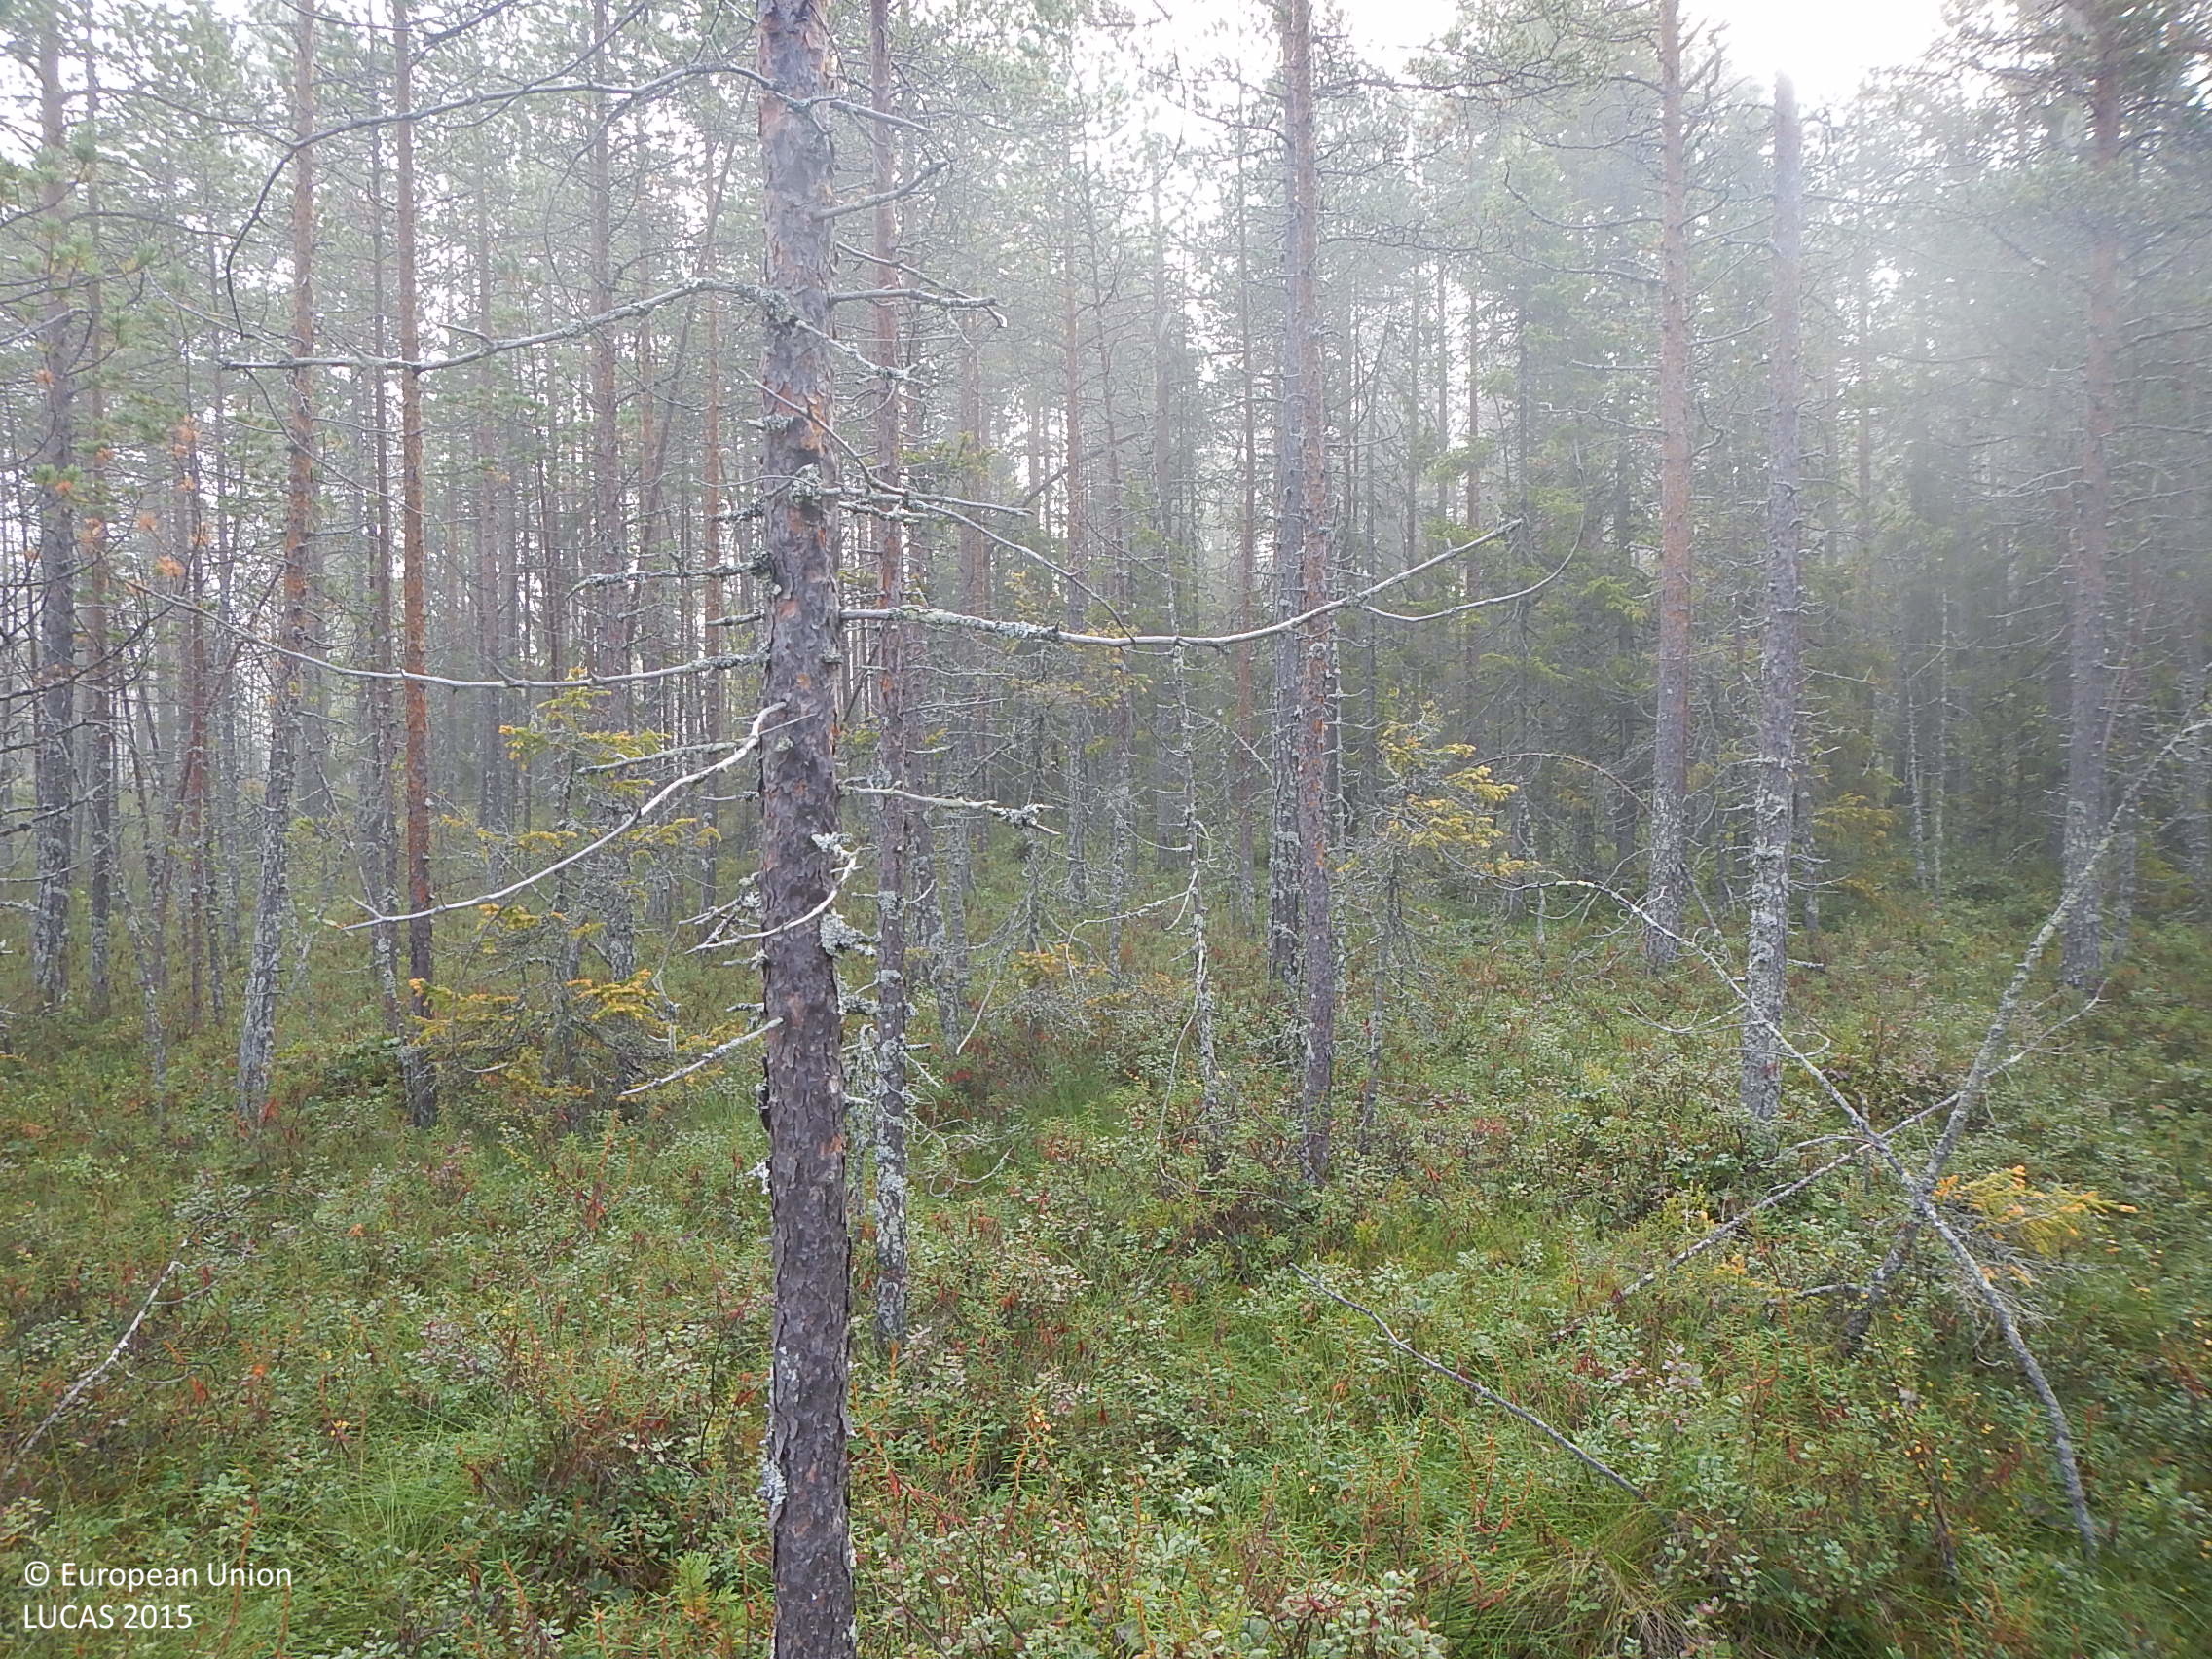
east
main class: Woodland
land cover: Pine dominated coniferous woodland
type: mire and swamp forests
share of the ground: 25 - 50 %
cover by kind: coniferous forest trees 45 %, shrubs 40 %, herbaceous plants 10 %, lichens and mosses 5 %
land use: Forestry
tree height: > 5 m
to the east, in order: Pine dominated coniferous woodland
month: August
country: FI
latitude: 65.5148
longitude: 27.0026
